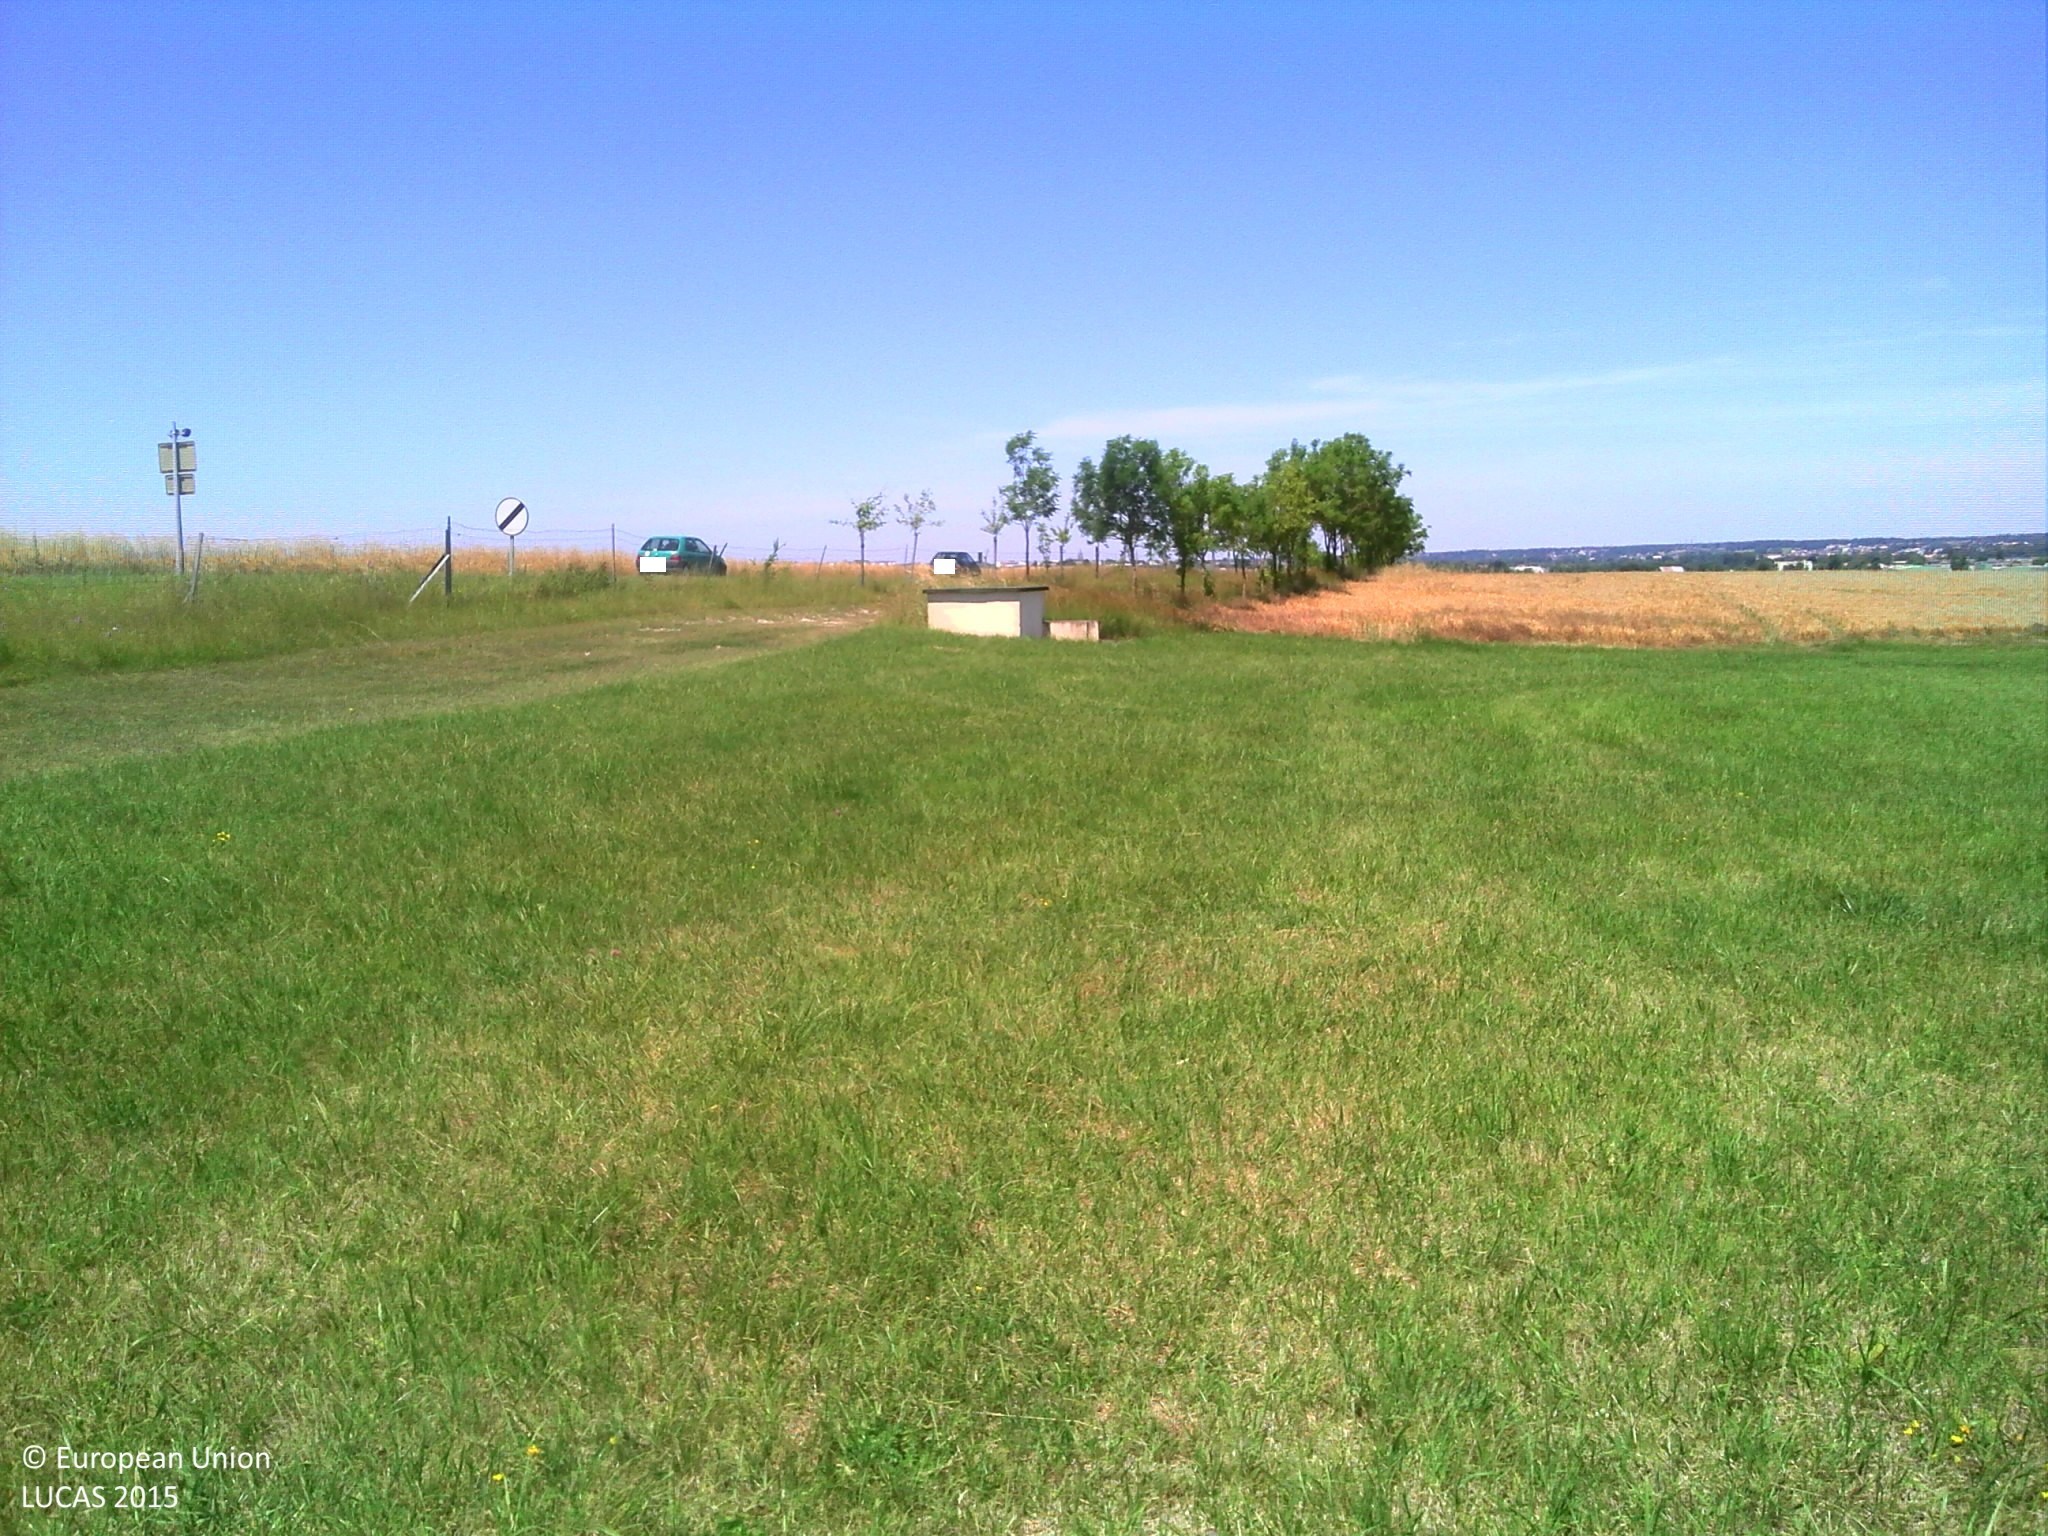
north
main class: Grassland
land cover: Grassland without tree/shrub cover
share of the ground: > 75 %
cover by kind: herbaceous plants 100 %
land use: Air transport
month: June
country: FR
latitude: 45.6915
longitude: -0.6437
